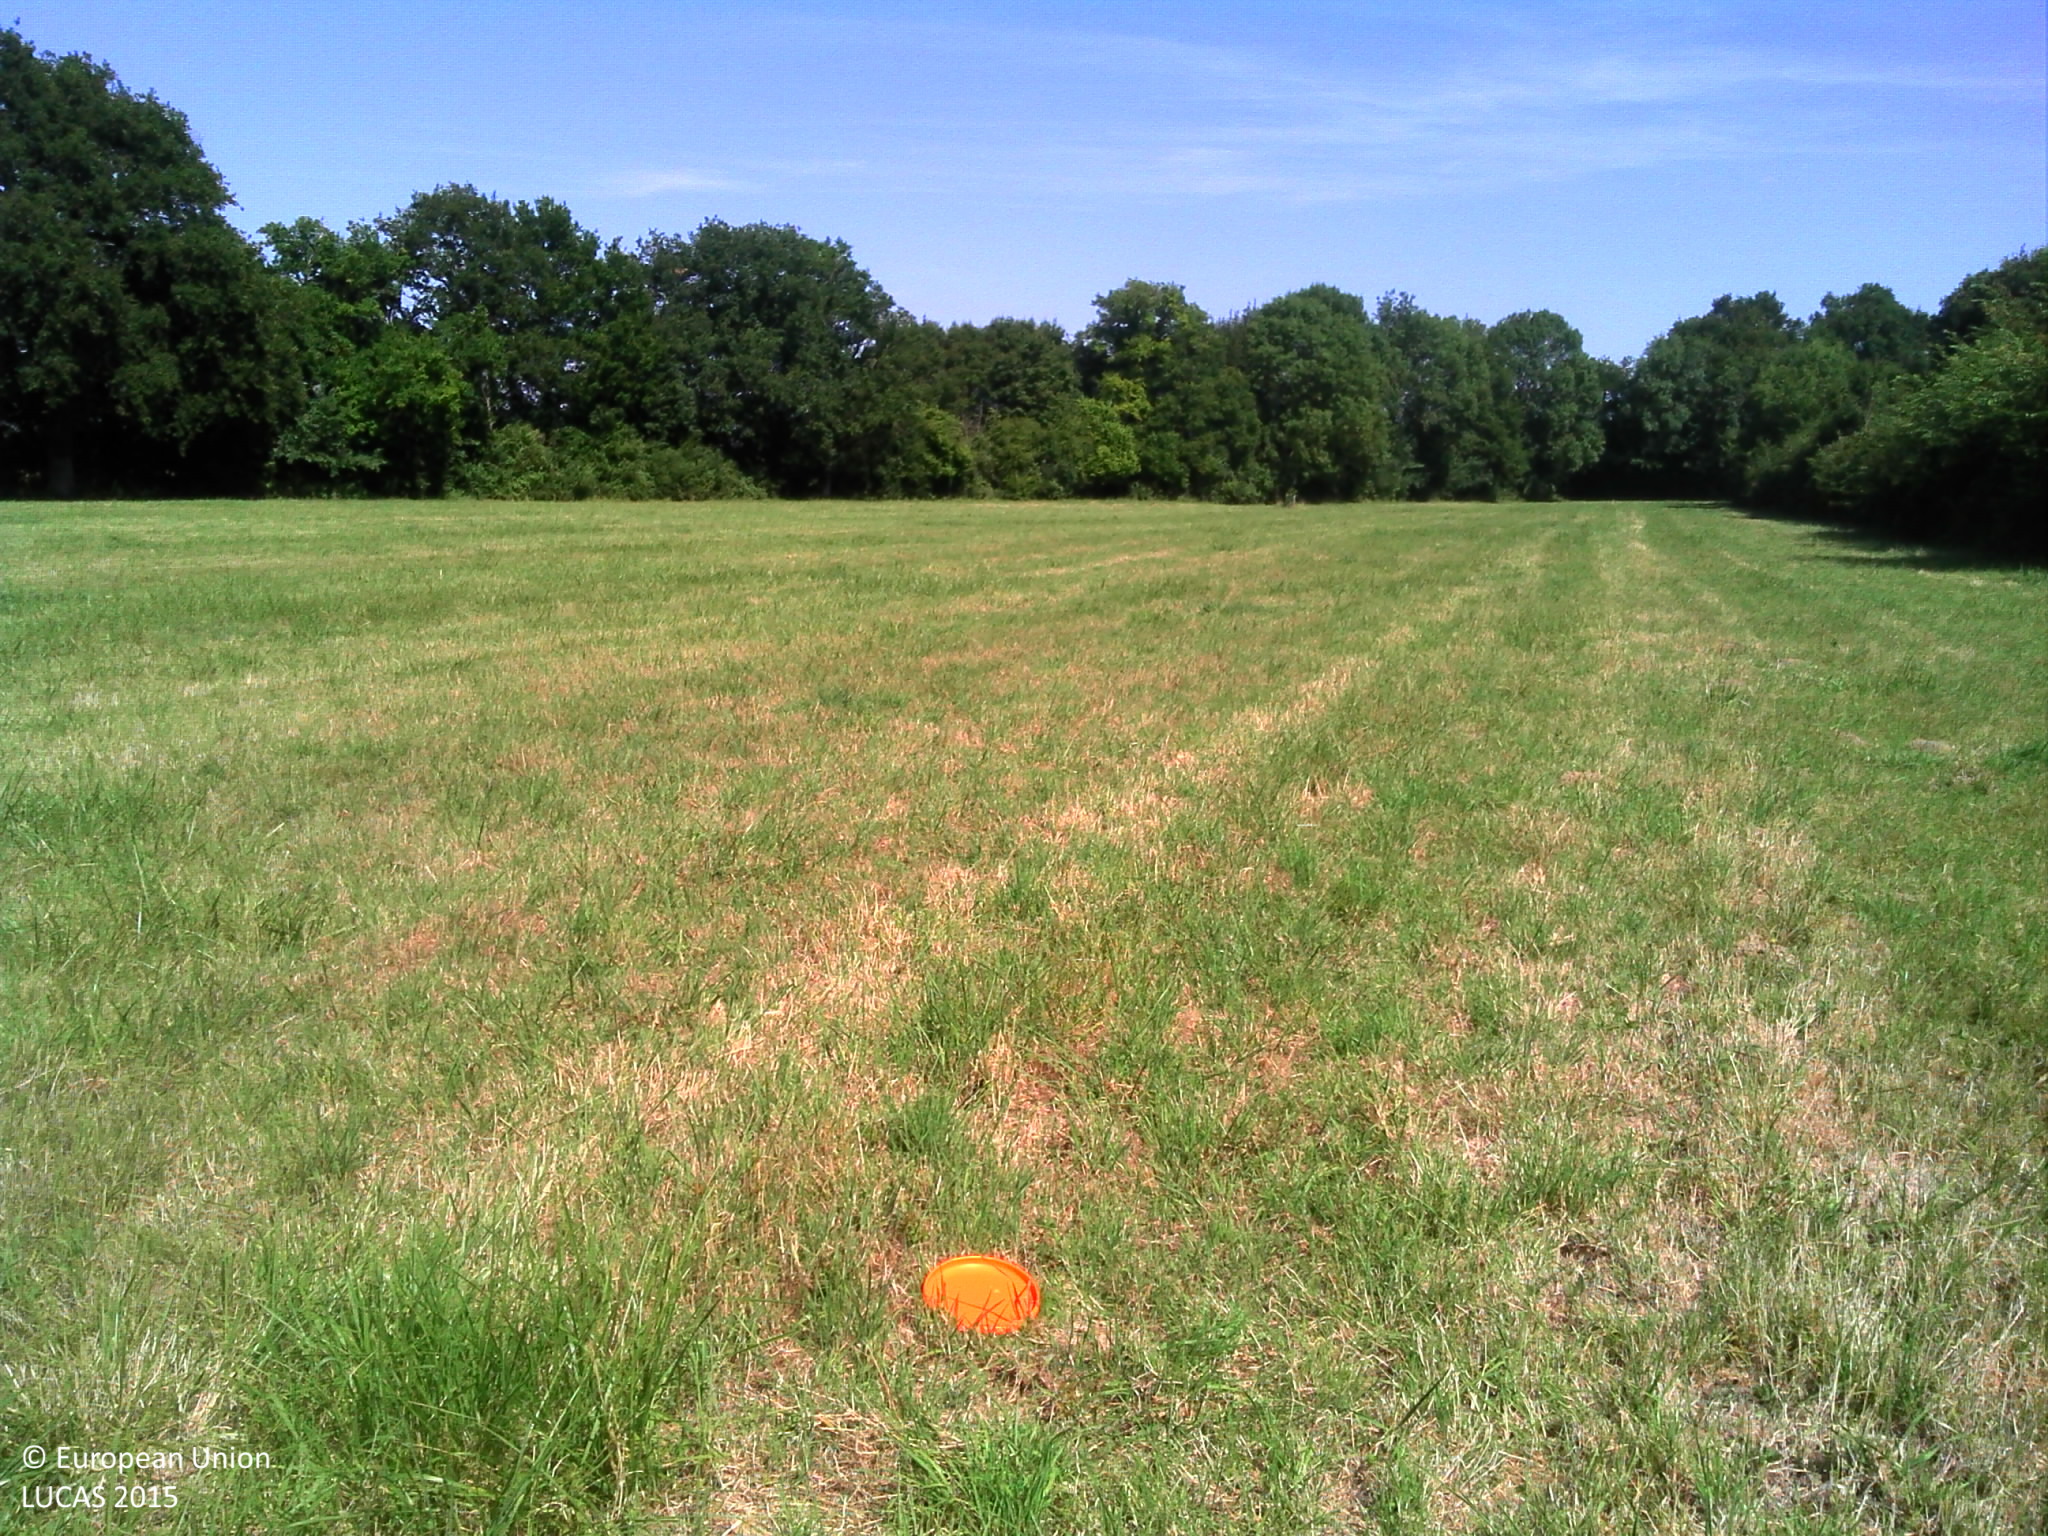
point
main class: Grassland
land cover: Grassland without tree/shrub cover
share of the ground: > 75 %
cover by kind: herbaceous plants 100 %
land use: Agriculture (excluding fallow land and kitchen gardens)
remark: Harvested field
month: June
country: FR
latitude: 47.5938
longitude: 0.2814
